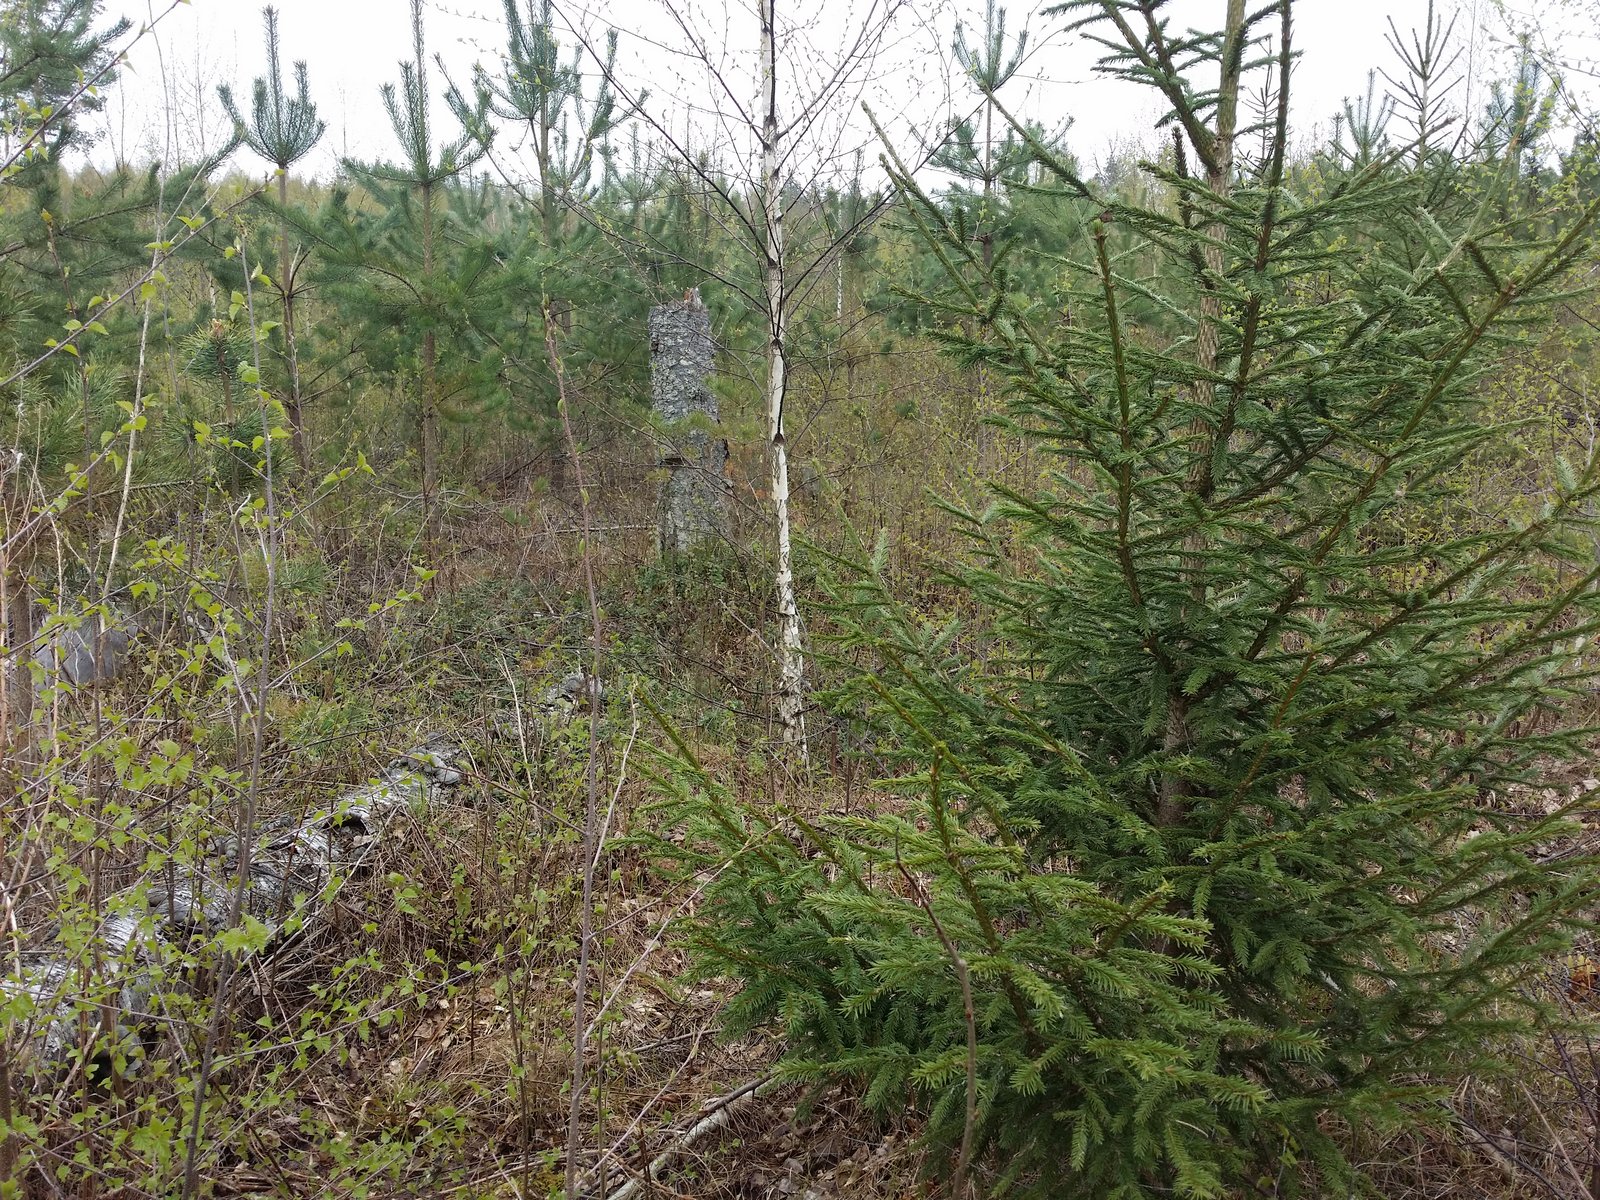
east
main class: Woodland
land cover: Other mixed woodland
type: hemiboreal forest and nemoral coniferous forest and mixed broadleaved-coniferous forest
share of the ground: 50 - 75 %
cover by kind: coniferous forest trees 40 %, broadleaved forest trees 40 %, lichens and mosses 20 %
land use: Forestry
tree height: < 5 m
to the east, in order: Other mixed woodland; Grass margins; Paved roads, cycling and walking lanes; Grass margins; Broadleaved woodland; Tracks; Other mixed woodland; Broadleaved woodland
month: May
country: LV
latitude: 57.4348
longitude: 26.0034
